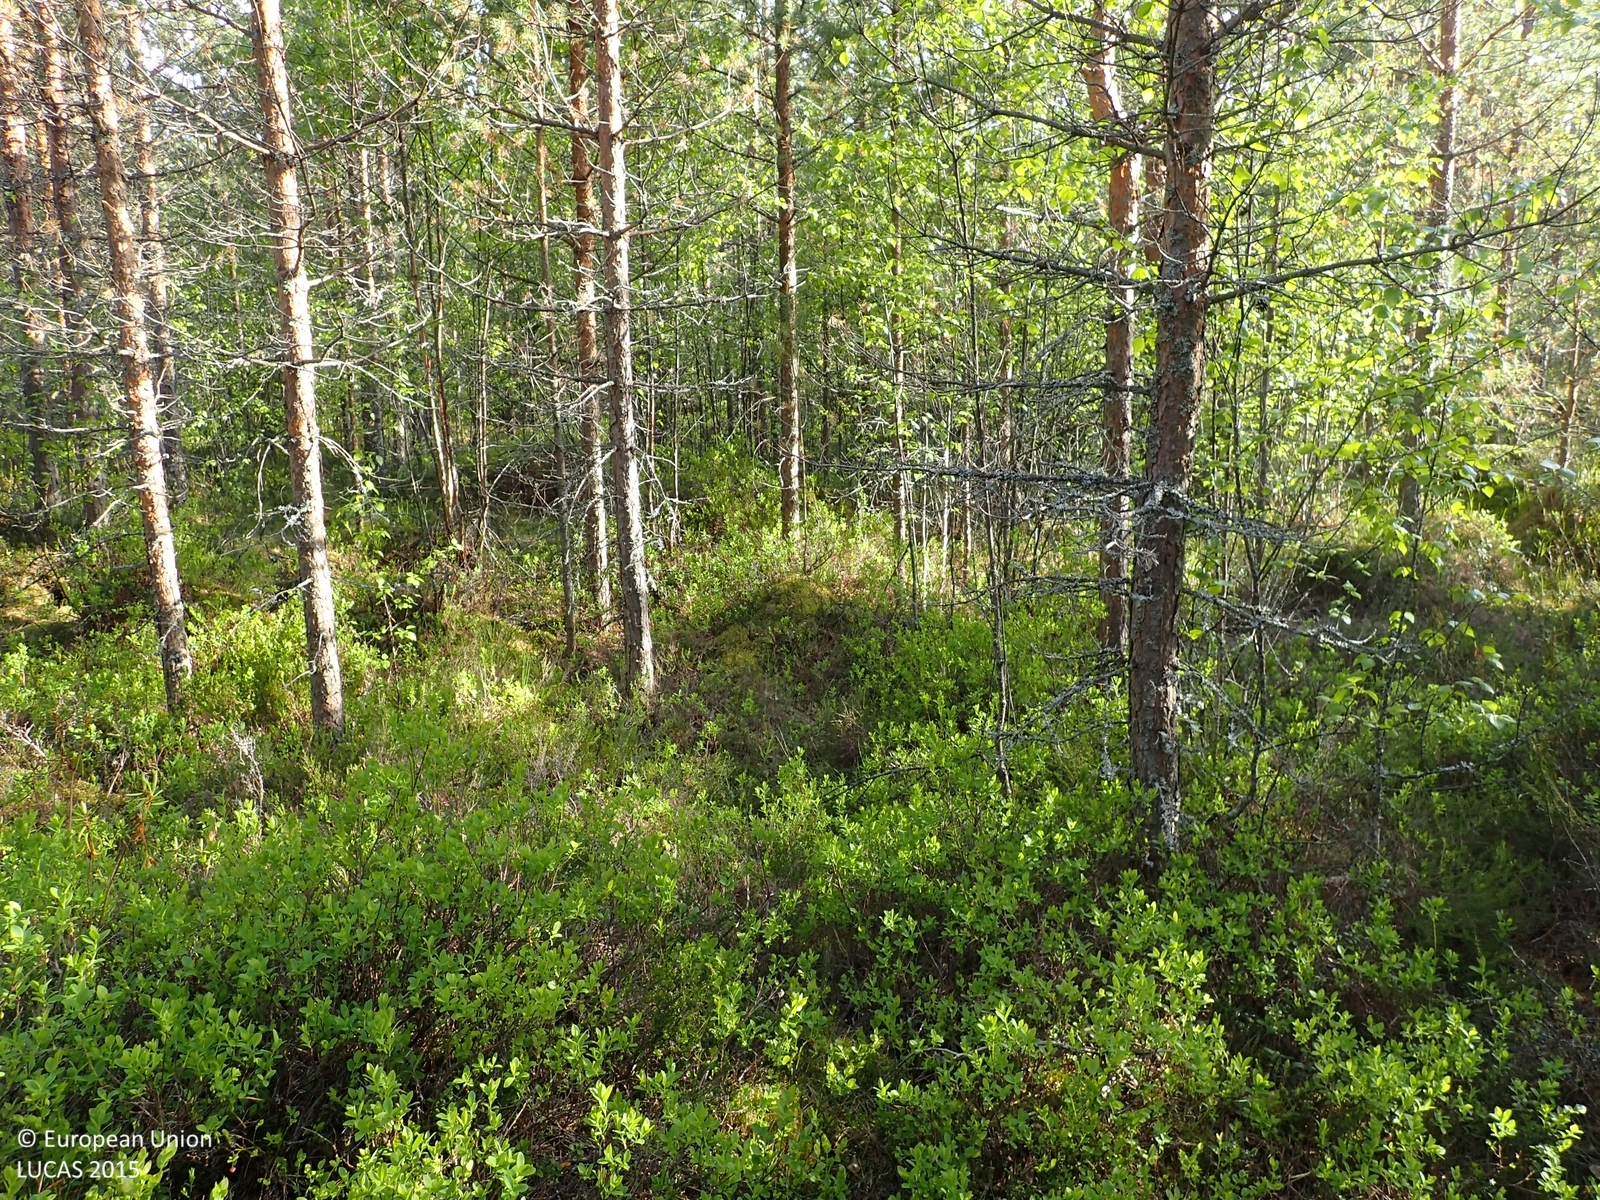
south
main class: Woodland
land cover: Pine dominated coniferous woodland
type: boreal forest
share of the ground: > 75 %
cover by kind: coniferous forest trees 80 %, shrubs 15 %, broadleaved forest trees 5 %
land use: Forestry
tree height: < 5 m
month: June
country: FI
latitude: 62.3763
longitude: 22.5658
